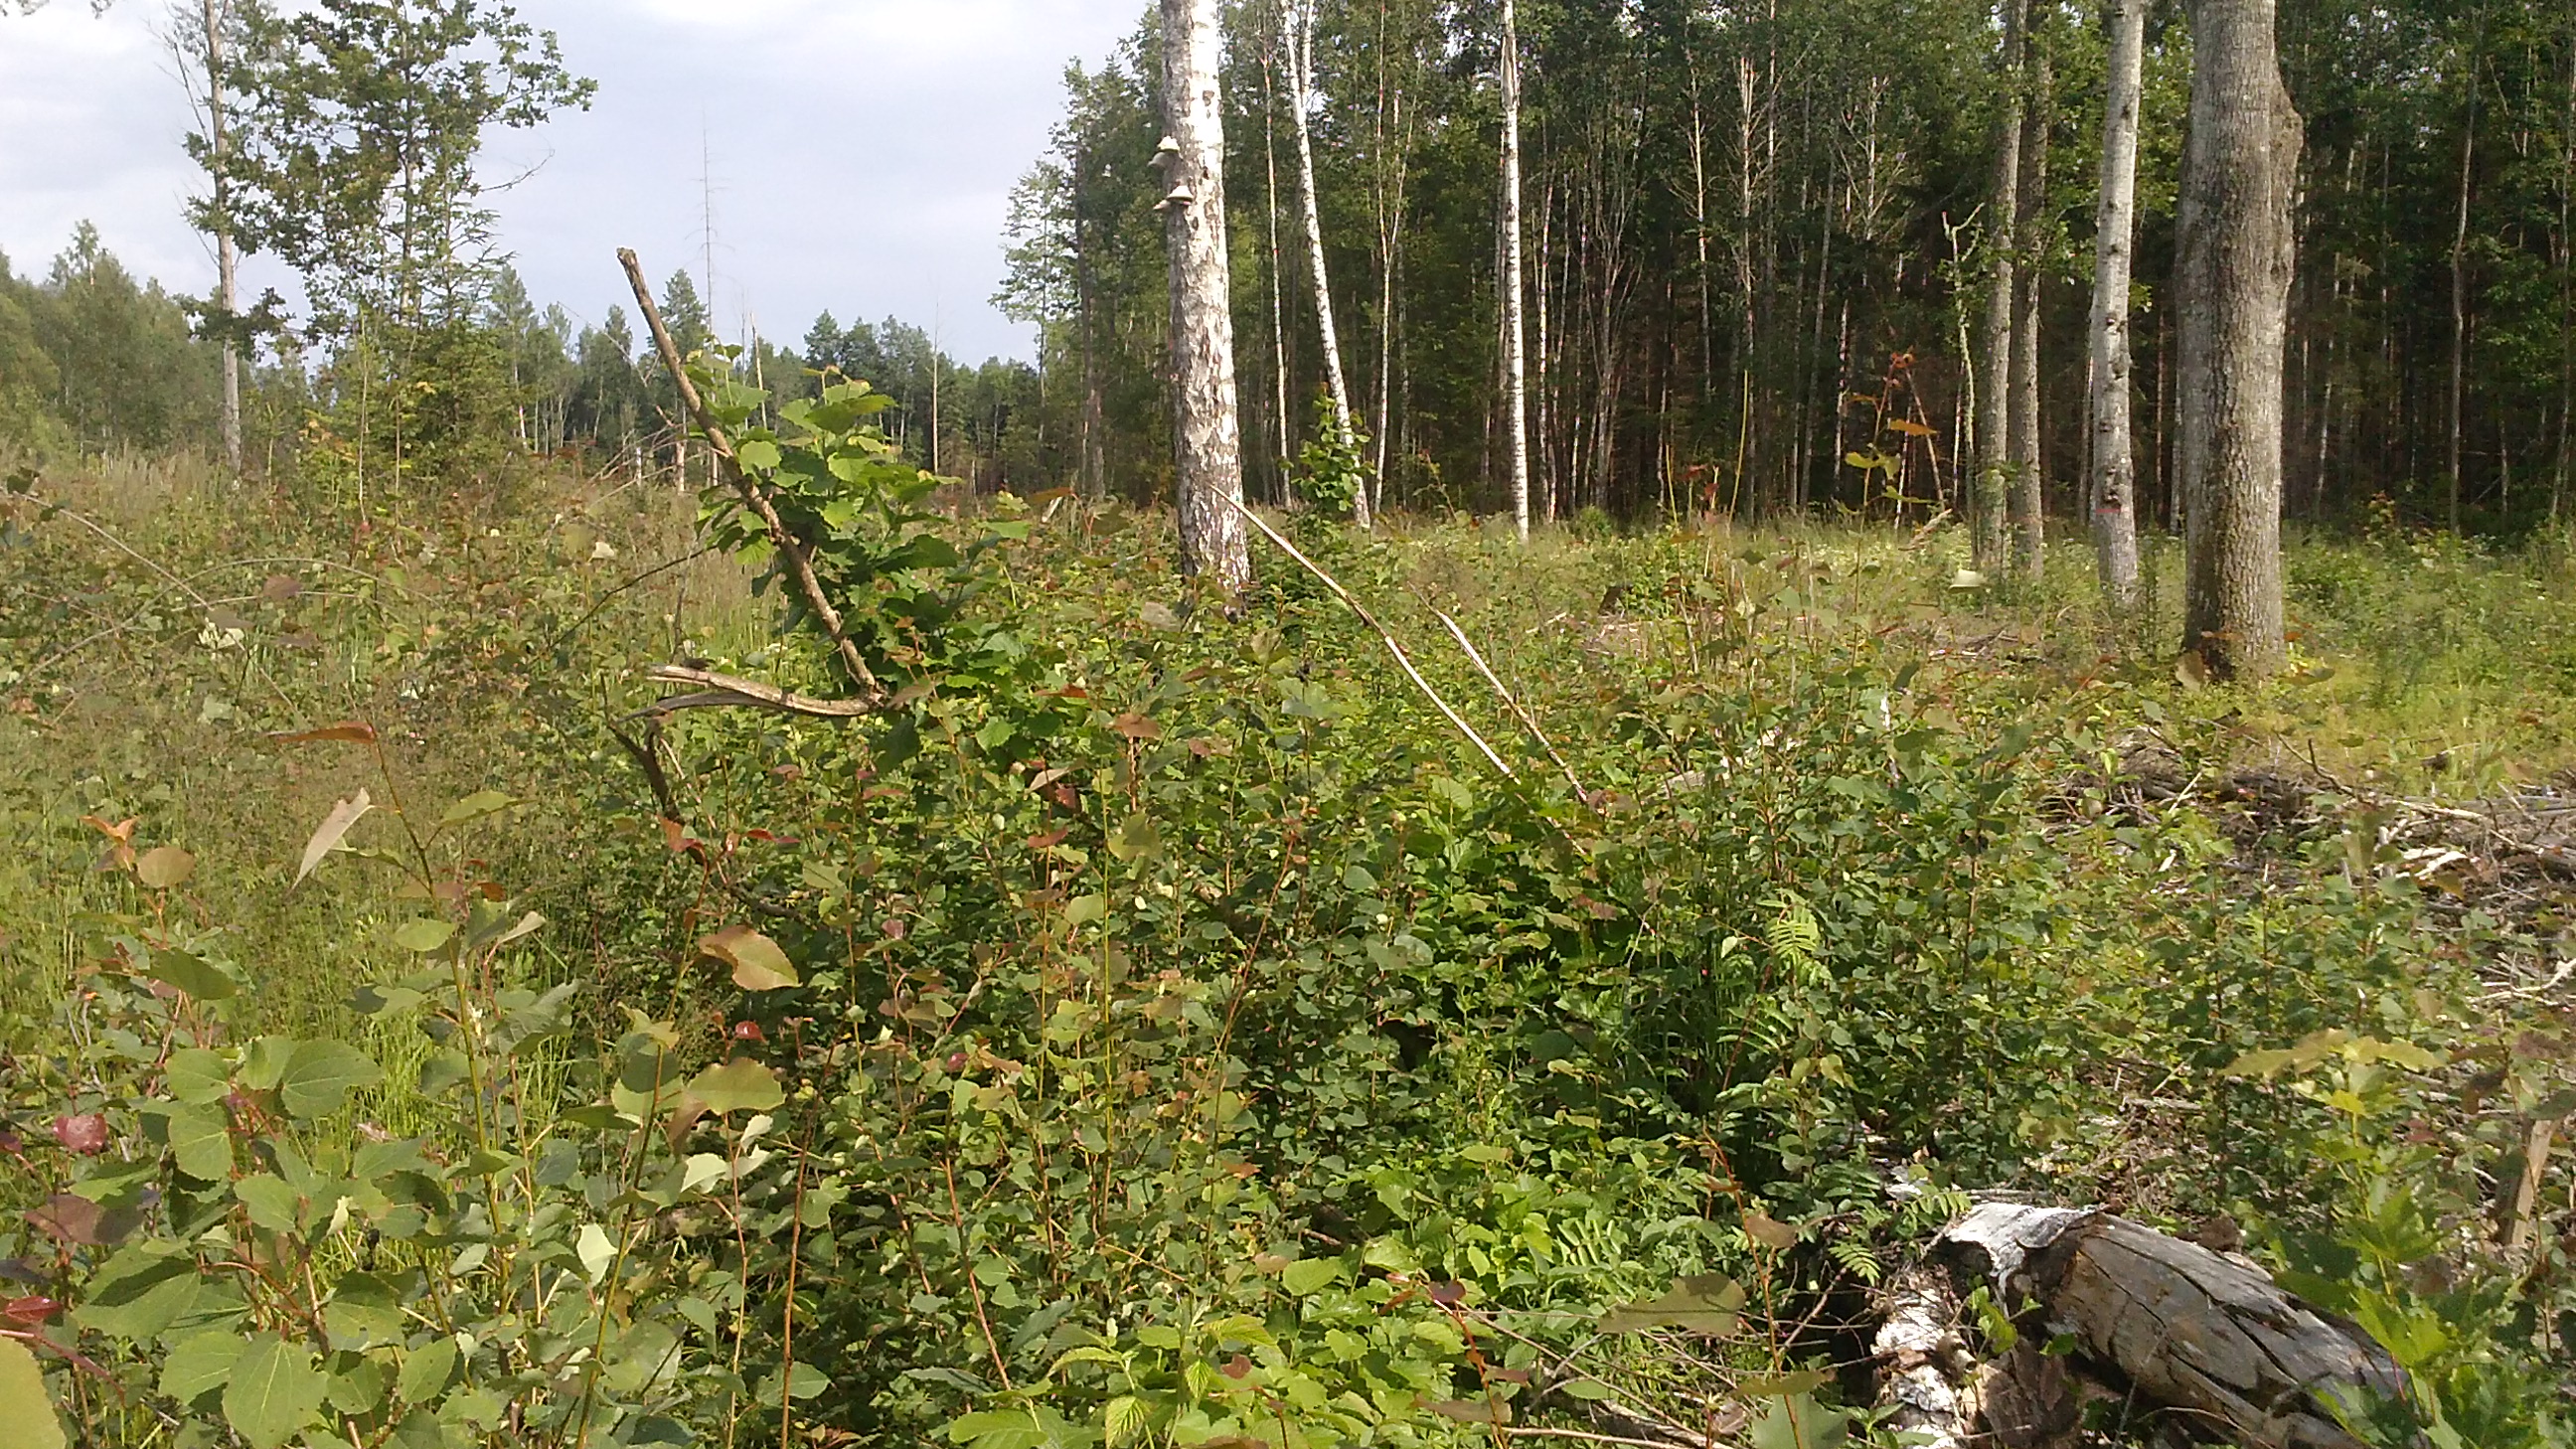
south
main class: Woodland
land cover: Broadleaved woodland
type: non-riverine alder, birch or aspen forest
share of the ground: > 75 %
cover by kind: broadleaved forest trees 100 %
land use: Forestry
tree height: < 5 m
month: June
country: LV
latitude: 56.6602
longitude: 27.9605
